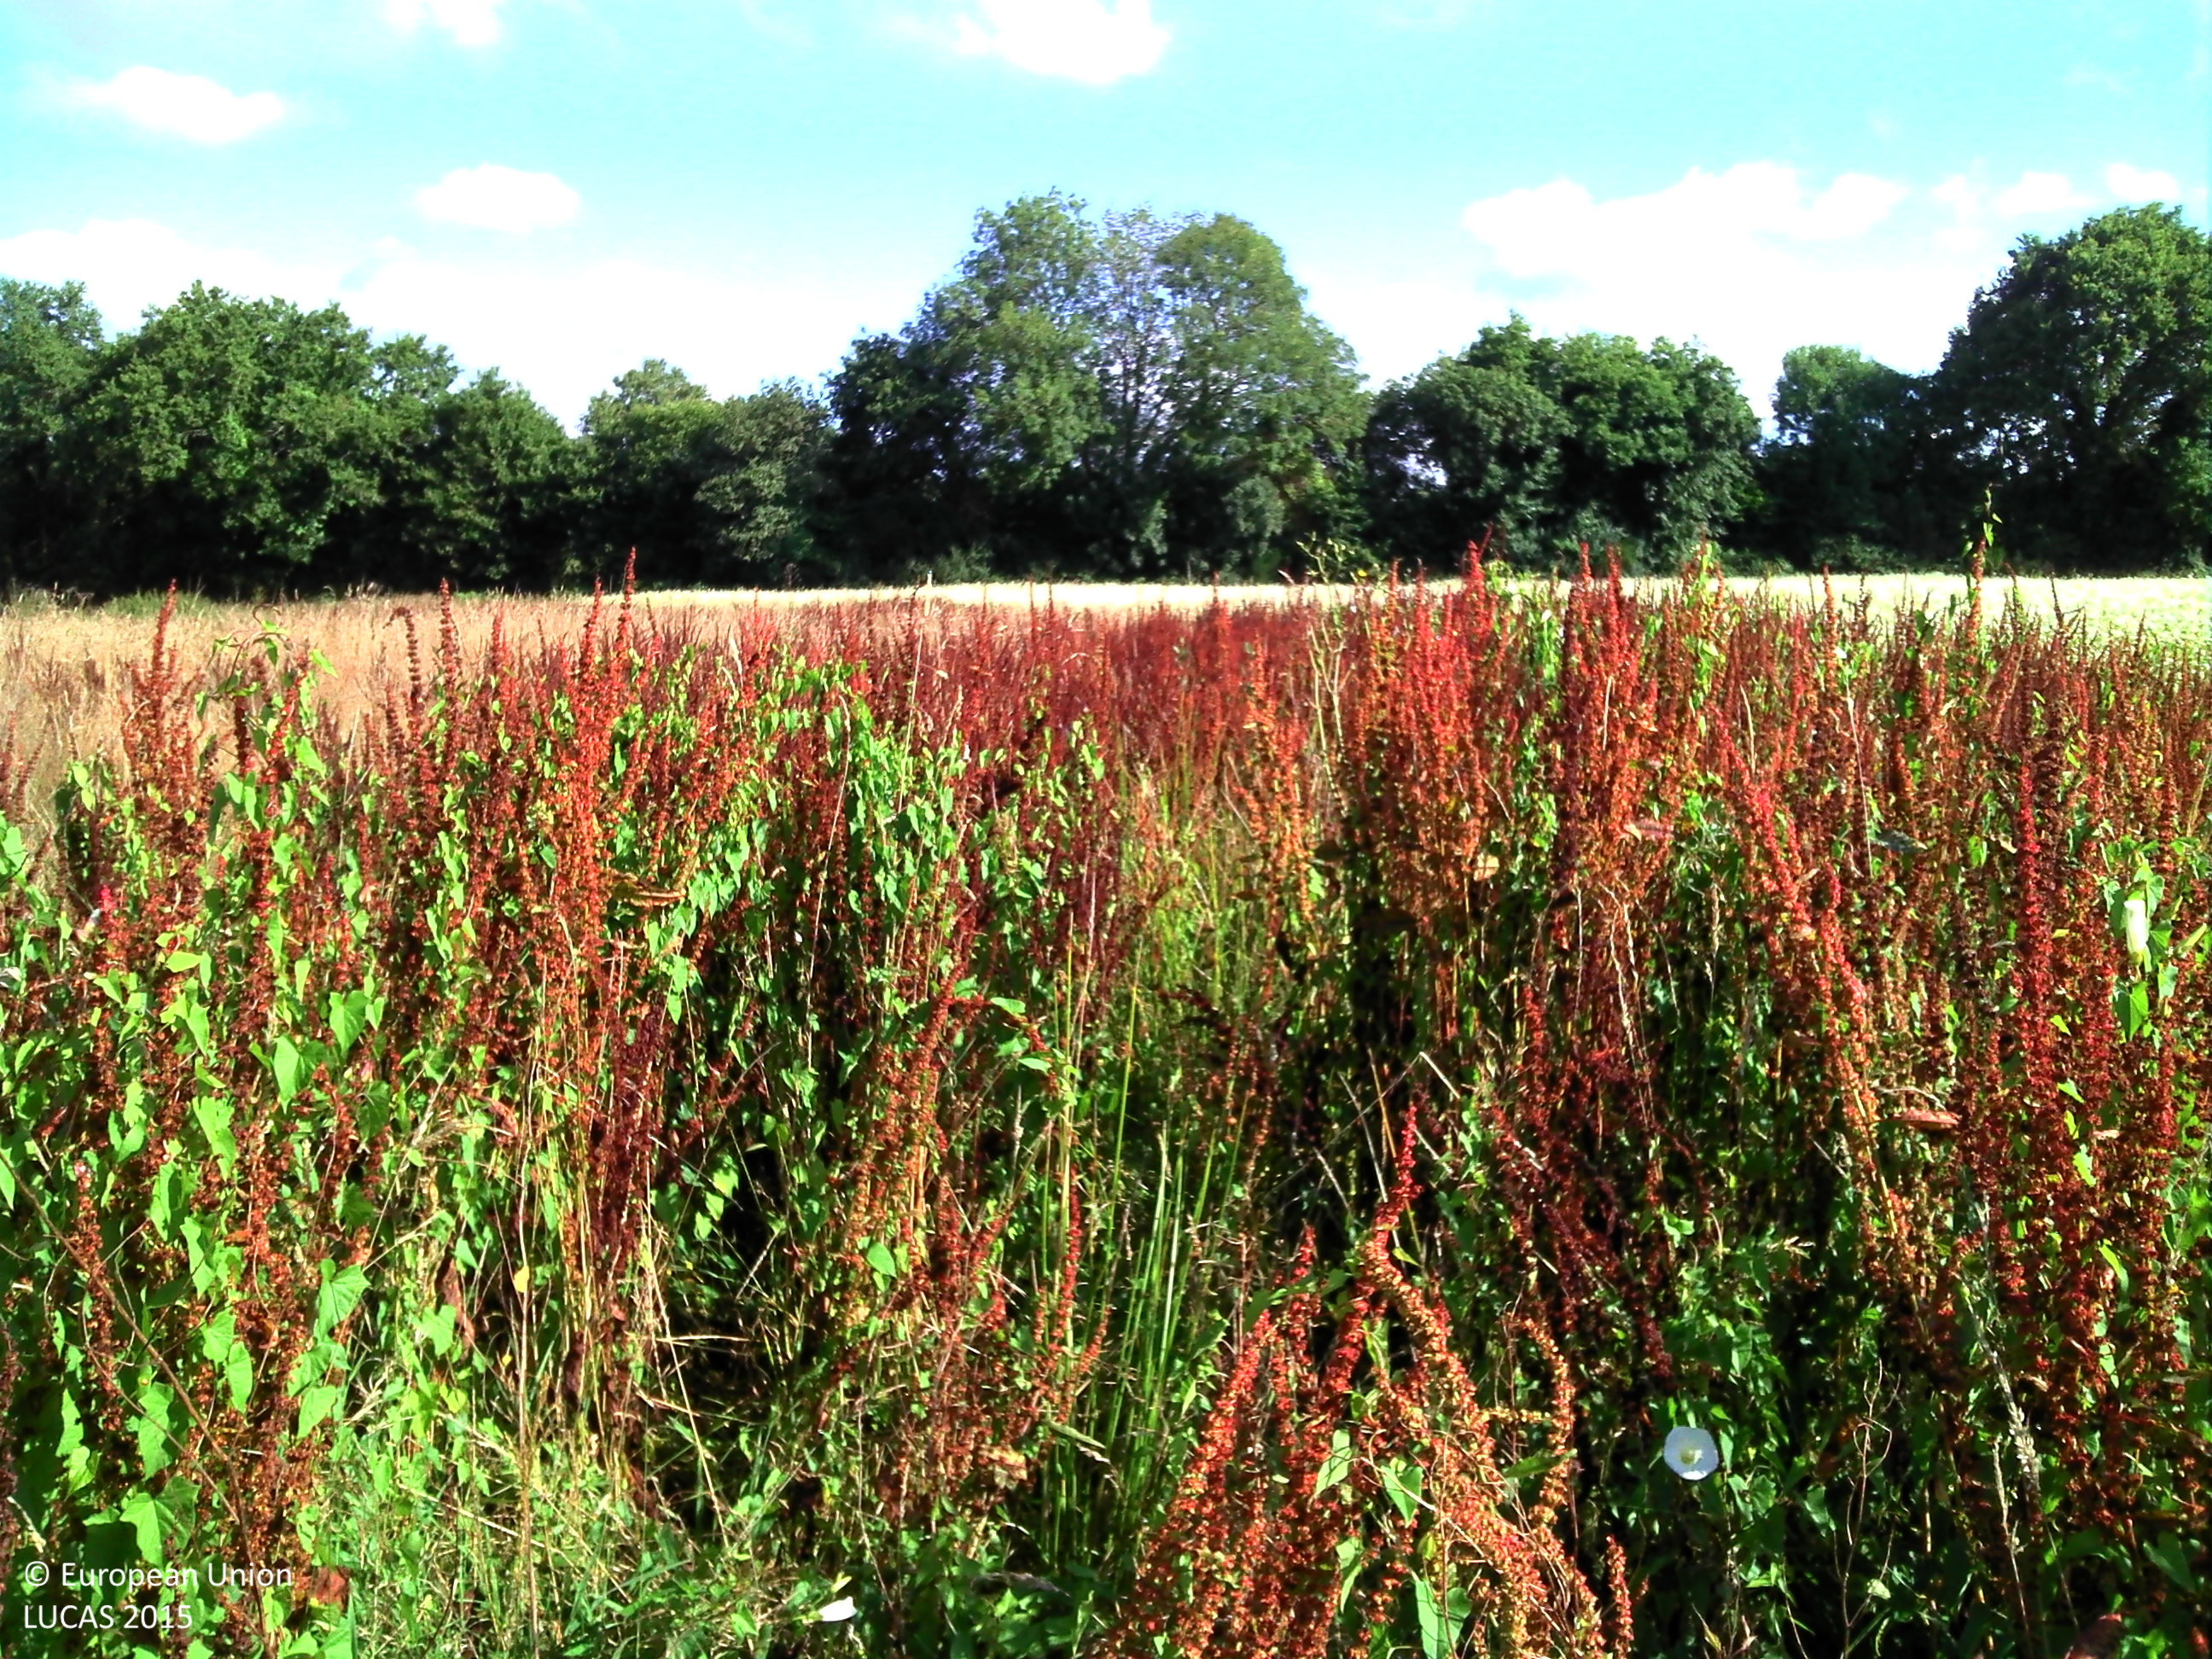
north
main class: Grassland
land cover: Spontaneously vegetated surfaces
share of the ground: > 75 %
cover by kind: herbaceous plants 80 %, consolidated bare surface 10 %, unconsolidated bare surface 10 %
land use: Fallow land
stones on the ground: < 10 %
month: July
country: FR
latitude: 47.7830
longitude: -3.1084
